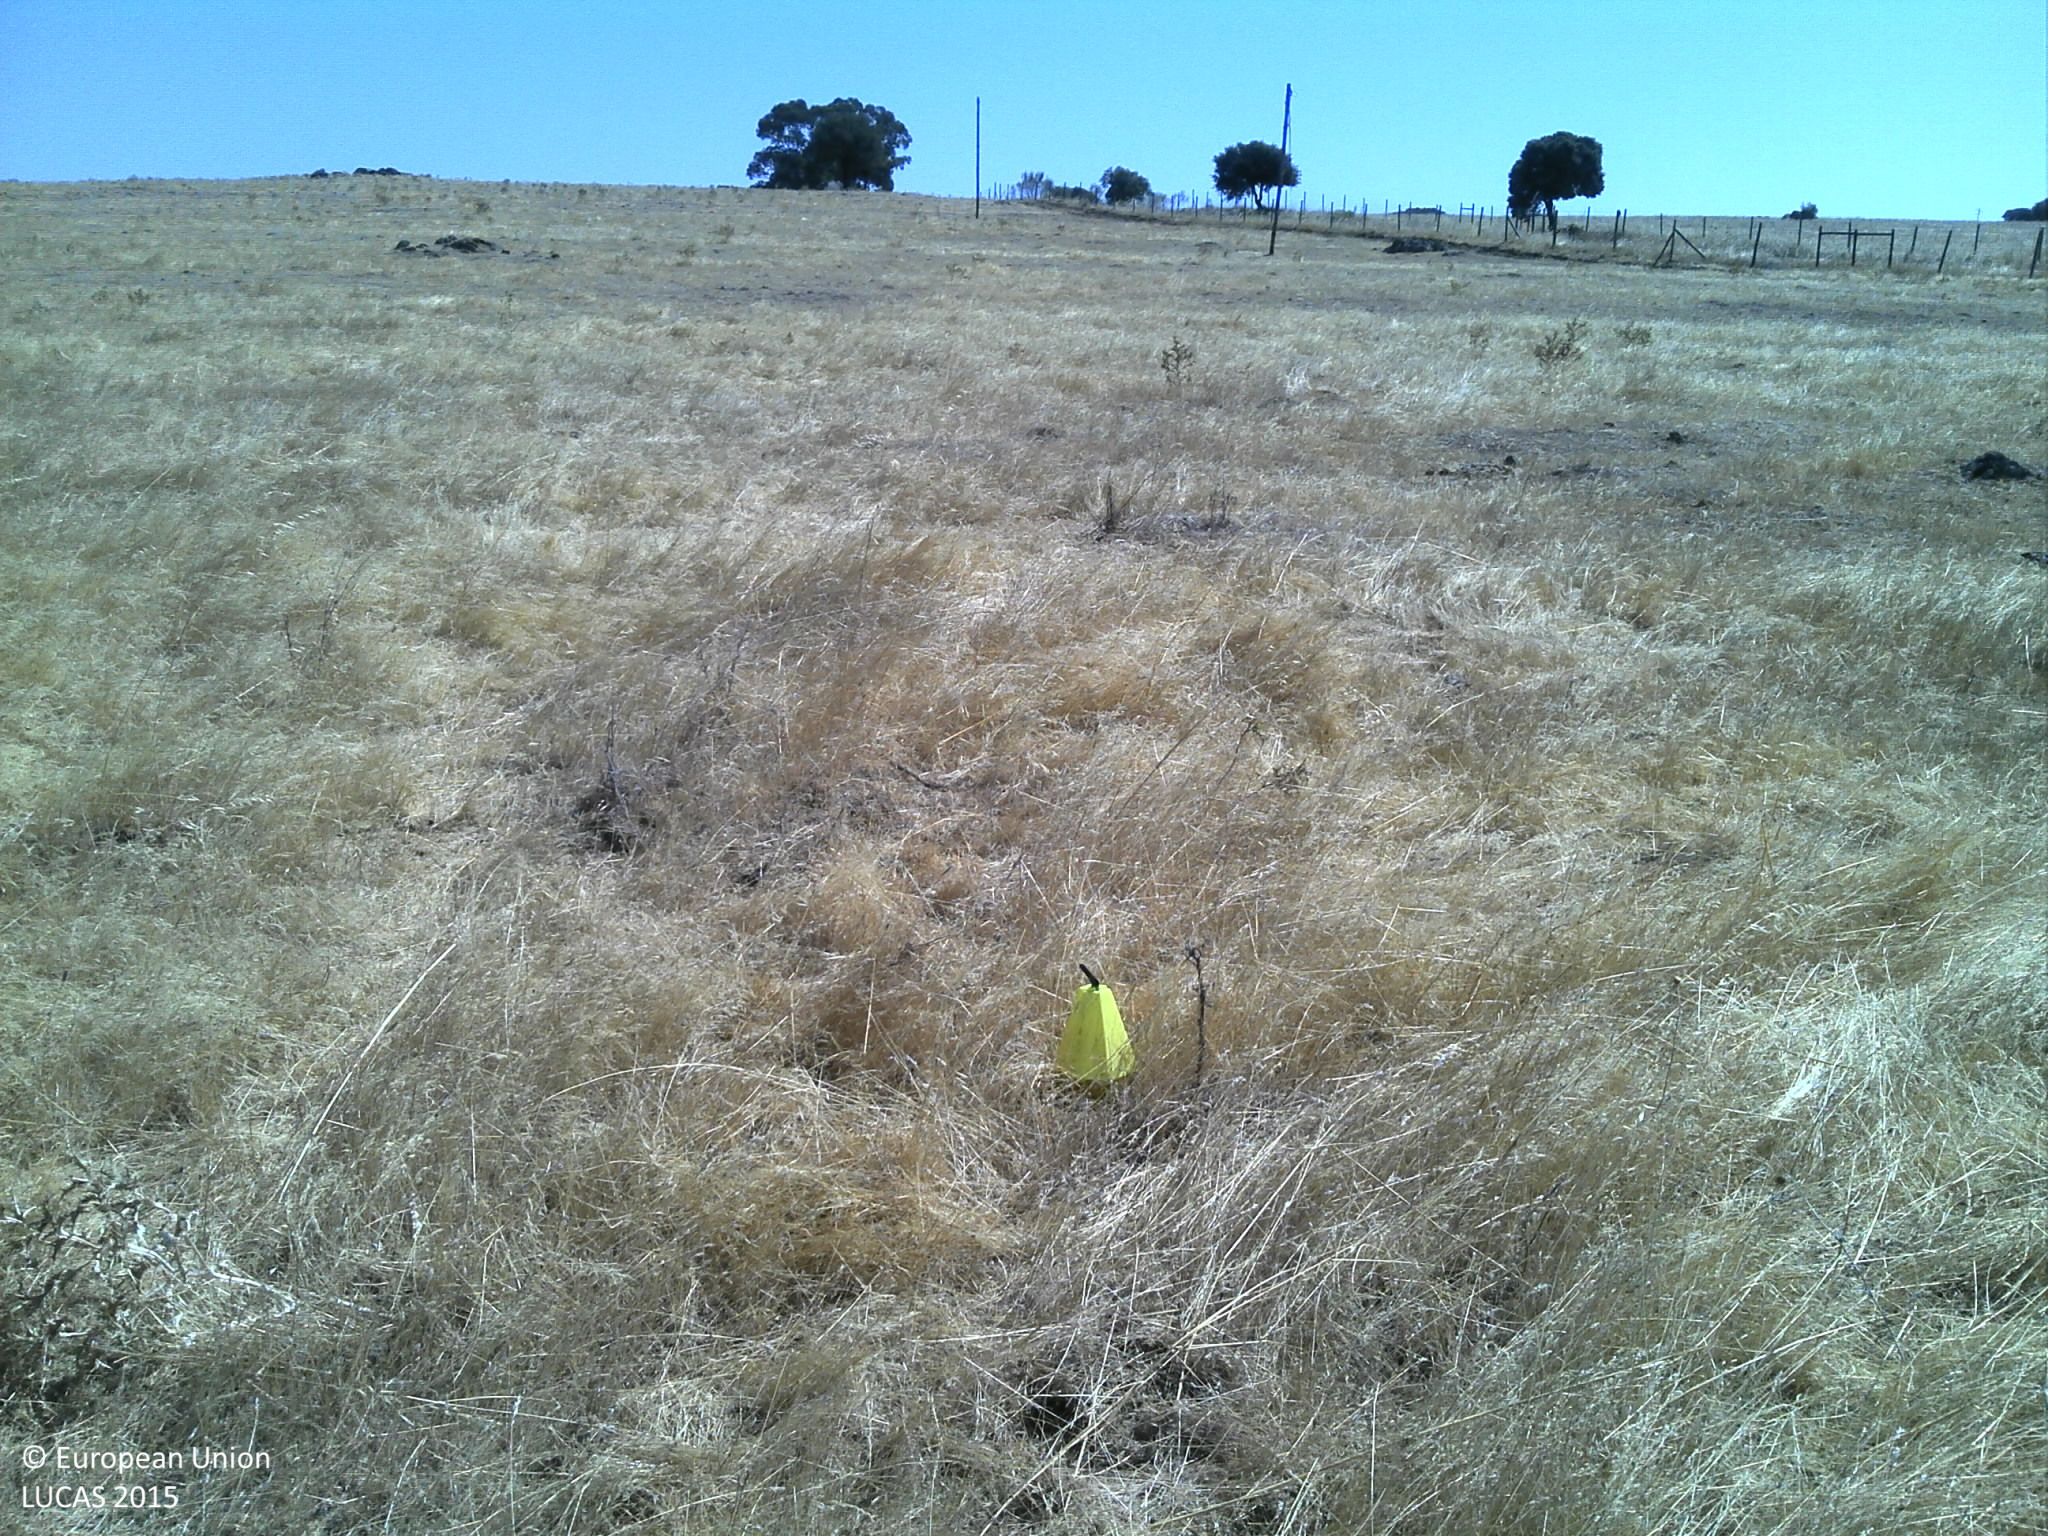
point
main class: Grassland
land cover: Grassland without tree/shrub cover
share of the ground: 50 - 75 %
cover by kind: herbaceous plants 60 %, unconsolidated bare surface 40 %
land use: Agriculture (excluding fallow land and kitchen gardens)
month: July
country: PT
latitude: 39.1195
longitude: -7.4221
